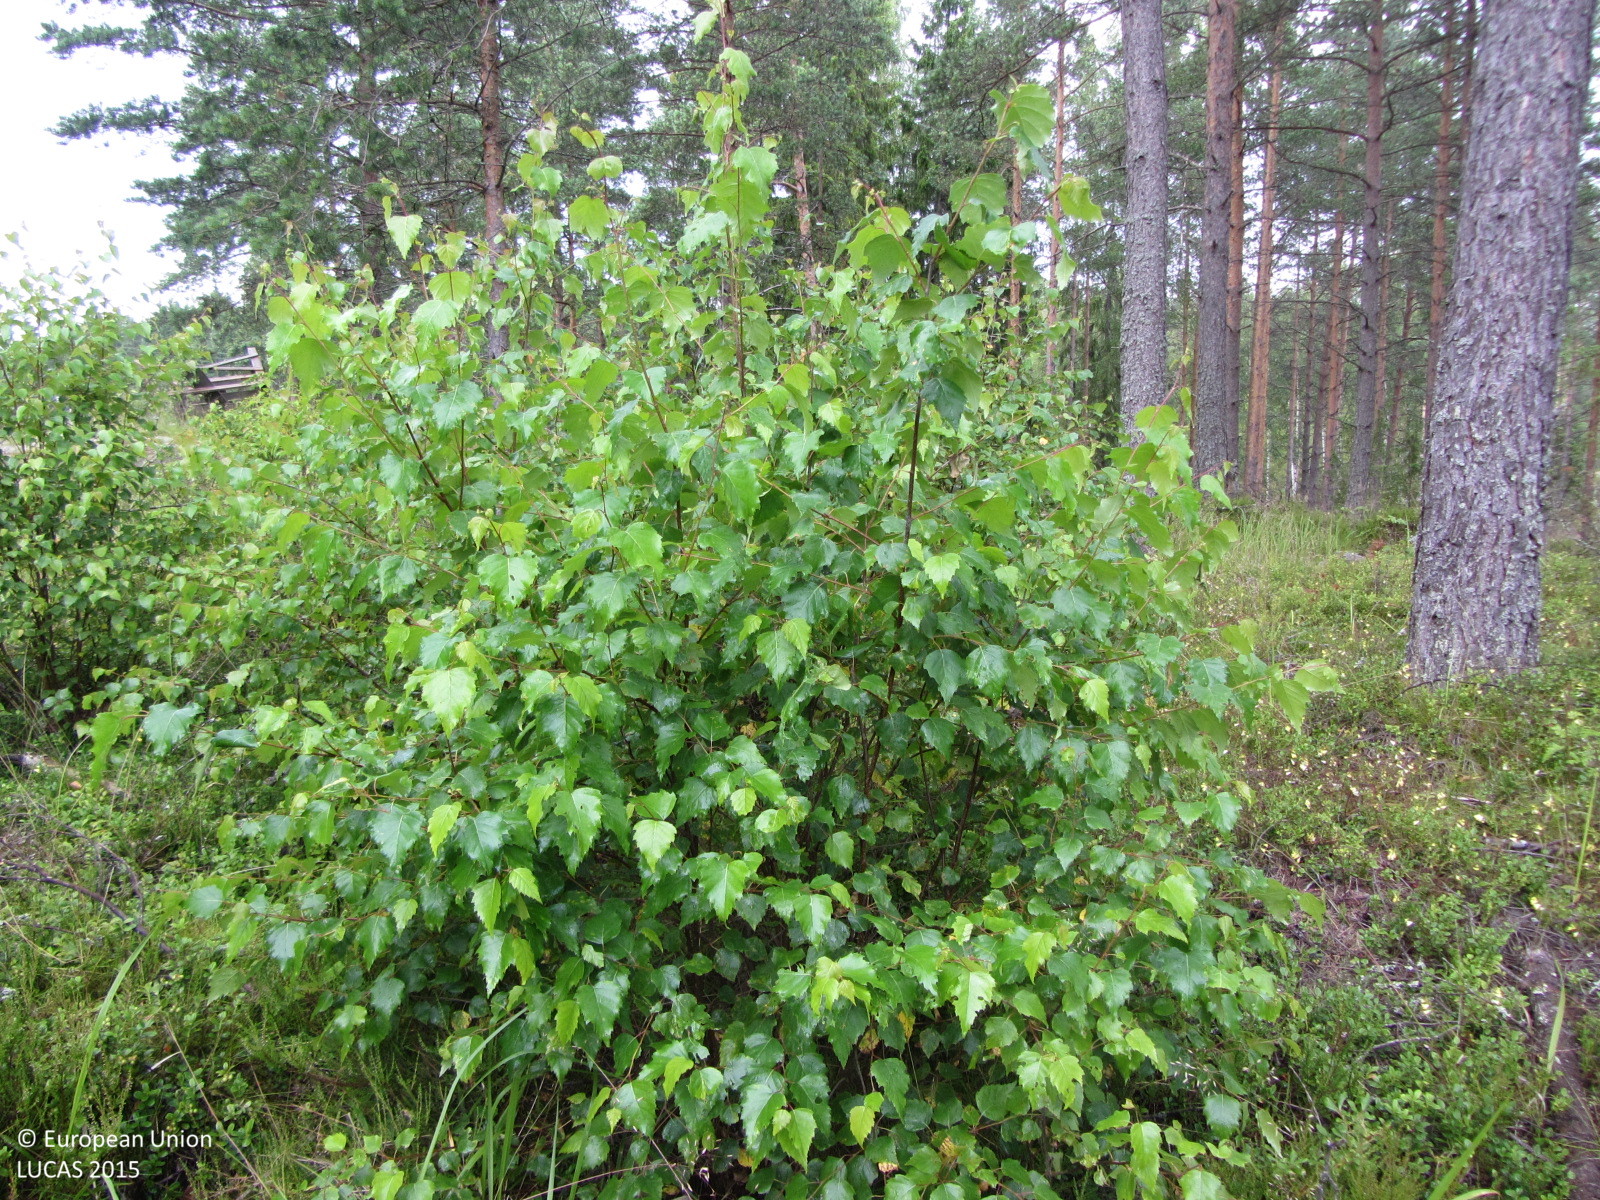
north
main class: Shrubland
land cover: Shrubland with sparse tree cover
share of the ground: > 75 %
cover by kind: shrubs 90 %, broadleaved forest trees 5 %, herbaceous plants 5 %
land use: Electricity, gas and thermal power distribution
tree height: < 5 m
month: July
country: FI
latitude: 60.0756
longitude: 24.2474
